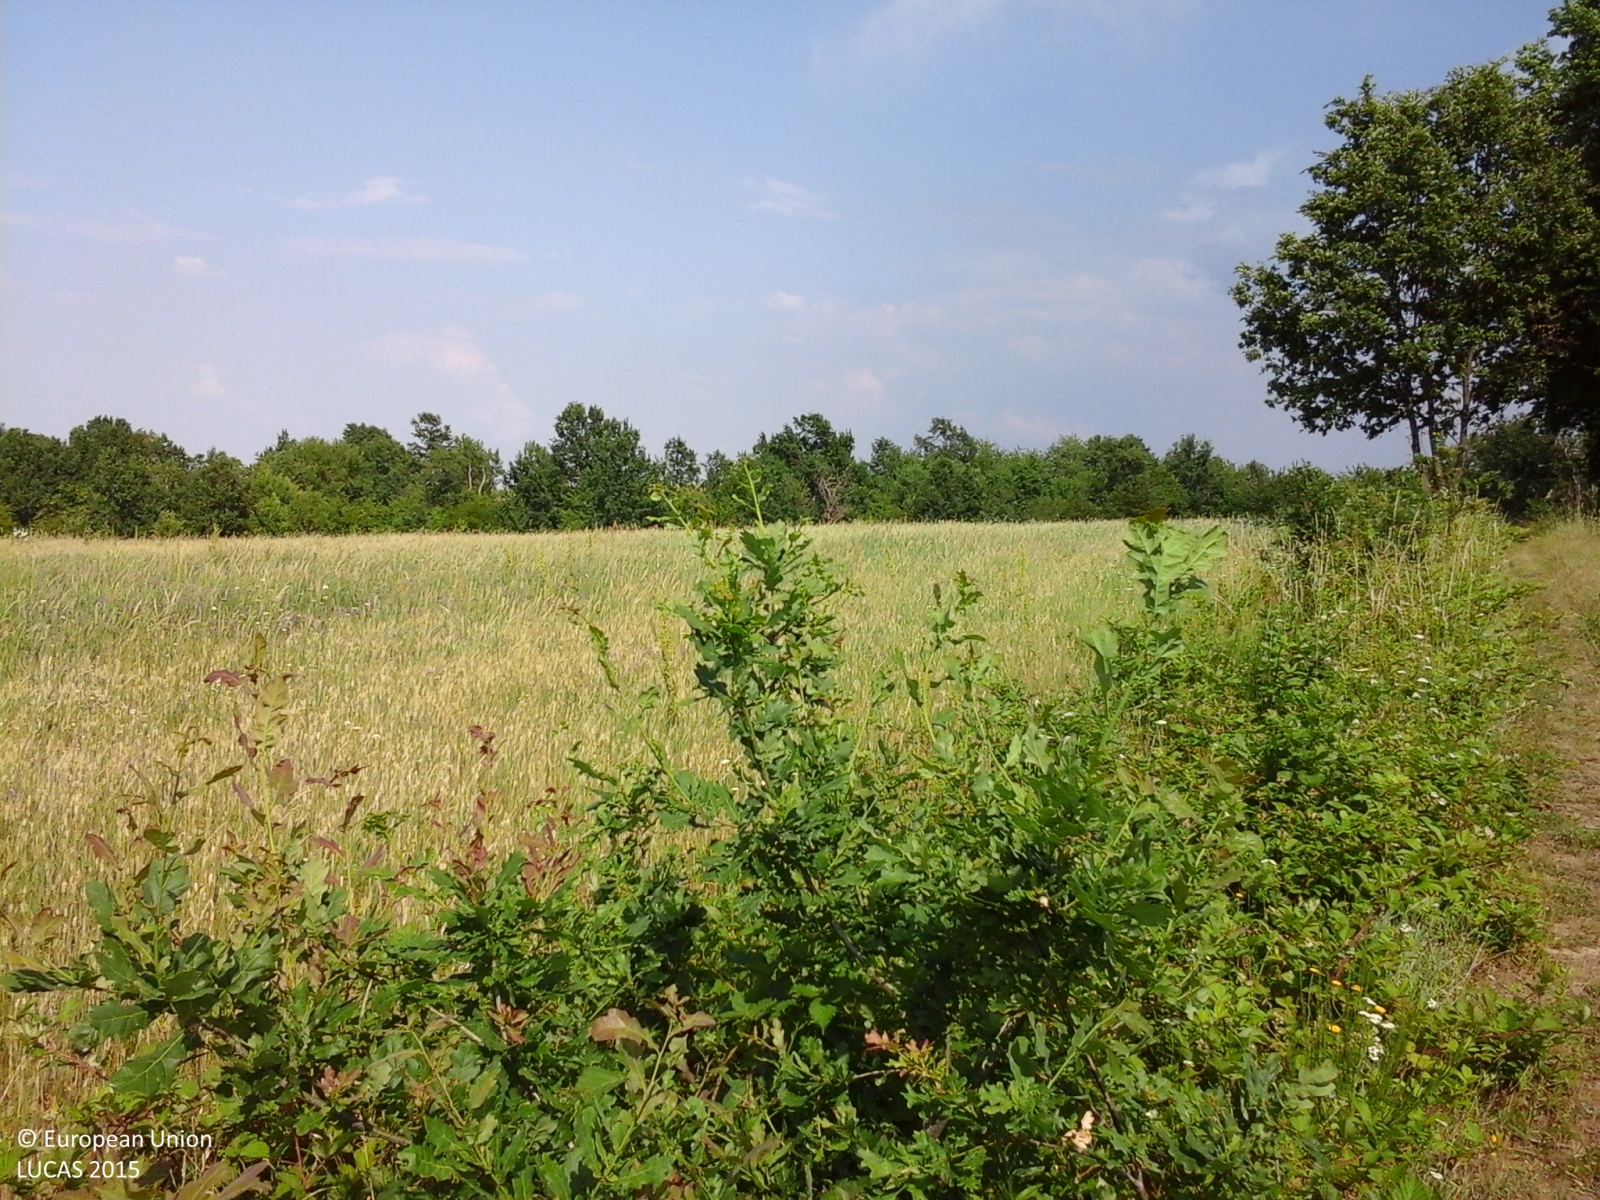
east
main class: Cropland
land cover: Common wheat
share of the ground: > 75 %
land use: Agriculture (excluding fallow land and kitchen gardens)
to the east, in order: Common wheat; Broadleaved woodland; Common wheat
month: June
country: IT
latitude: 44.7199
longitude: 8.6016
